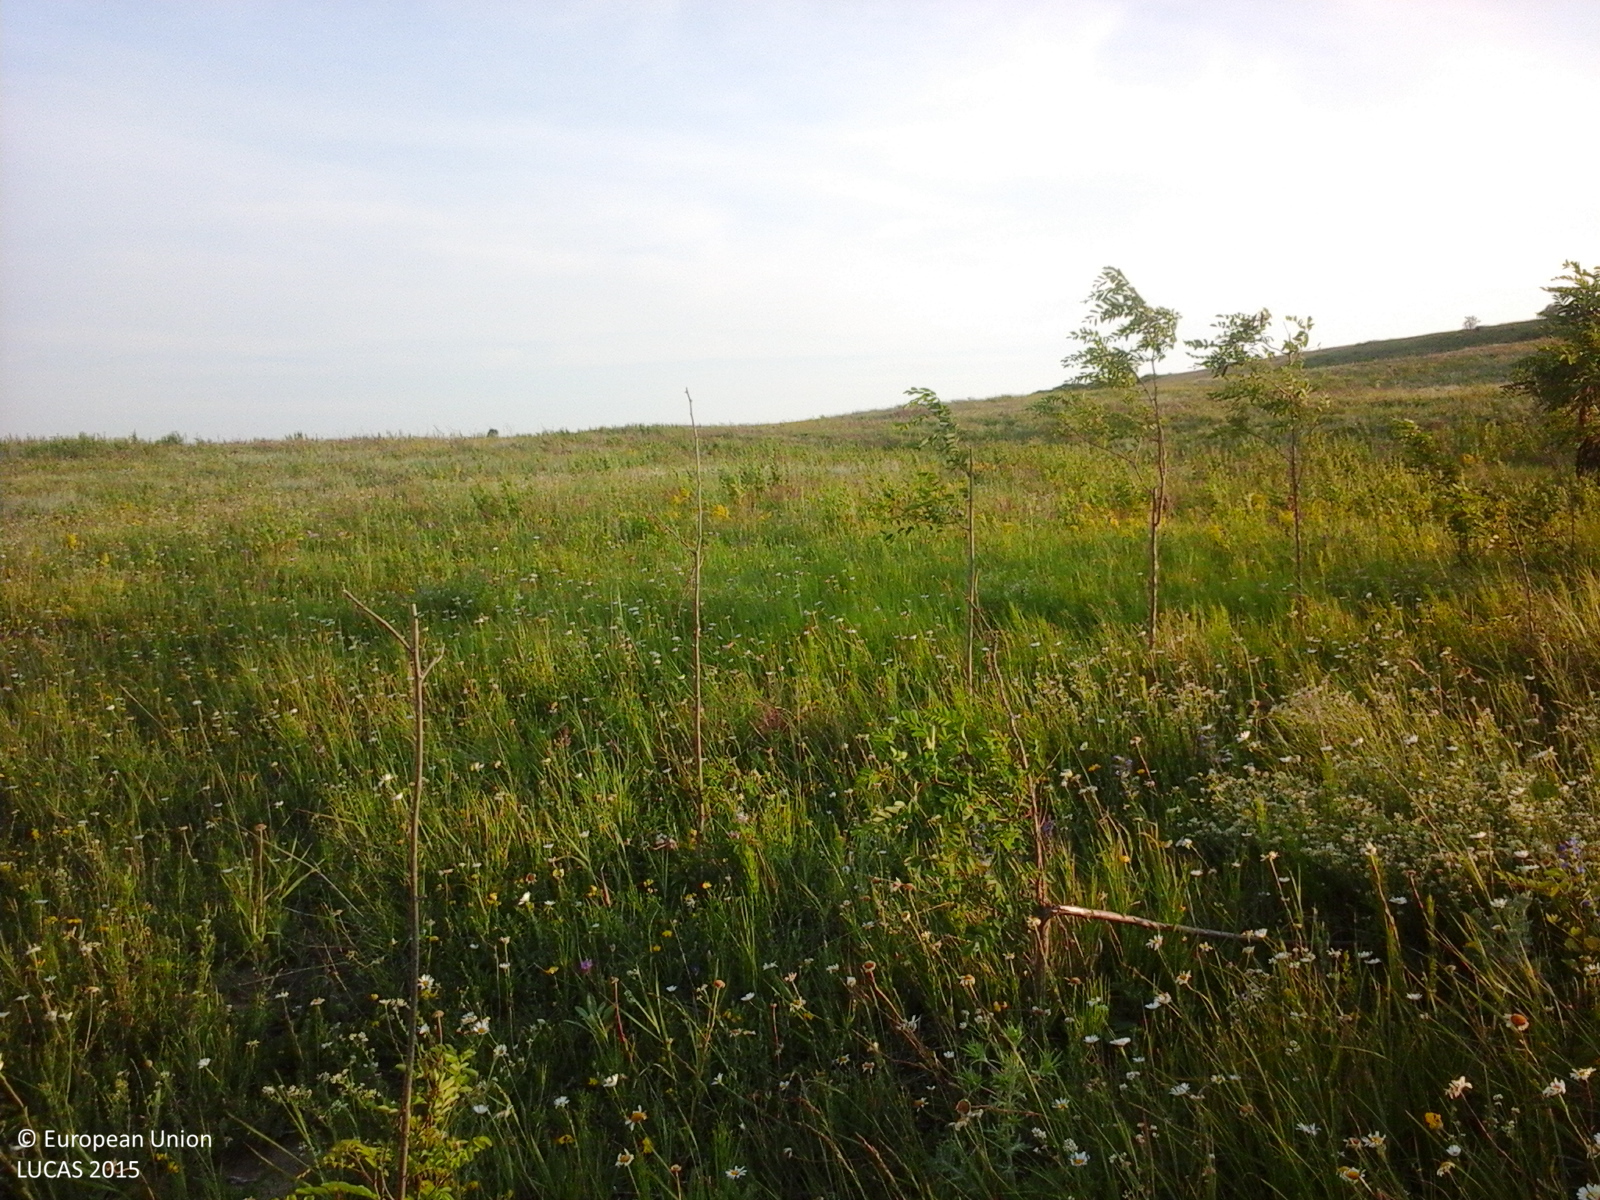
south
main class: Grassland
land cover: Grassland with sparse tree/shrub cover
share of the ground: > 75 %
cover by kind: herbaceous plants 90 %, broadleaved forest trees 5 %, shrubs 5 %
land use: Agriculture (excluding fallow land and kitchen gardens)
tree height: < 5 m
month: June
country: RO
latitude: 46.6690
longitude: 27.4556
